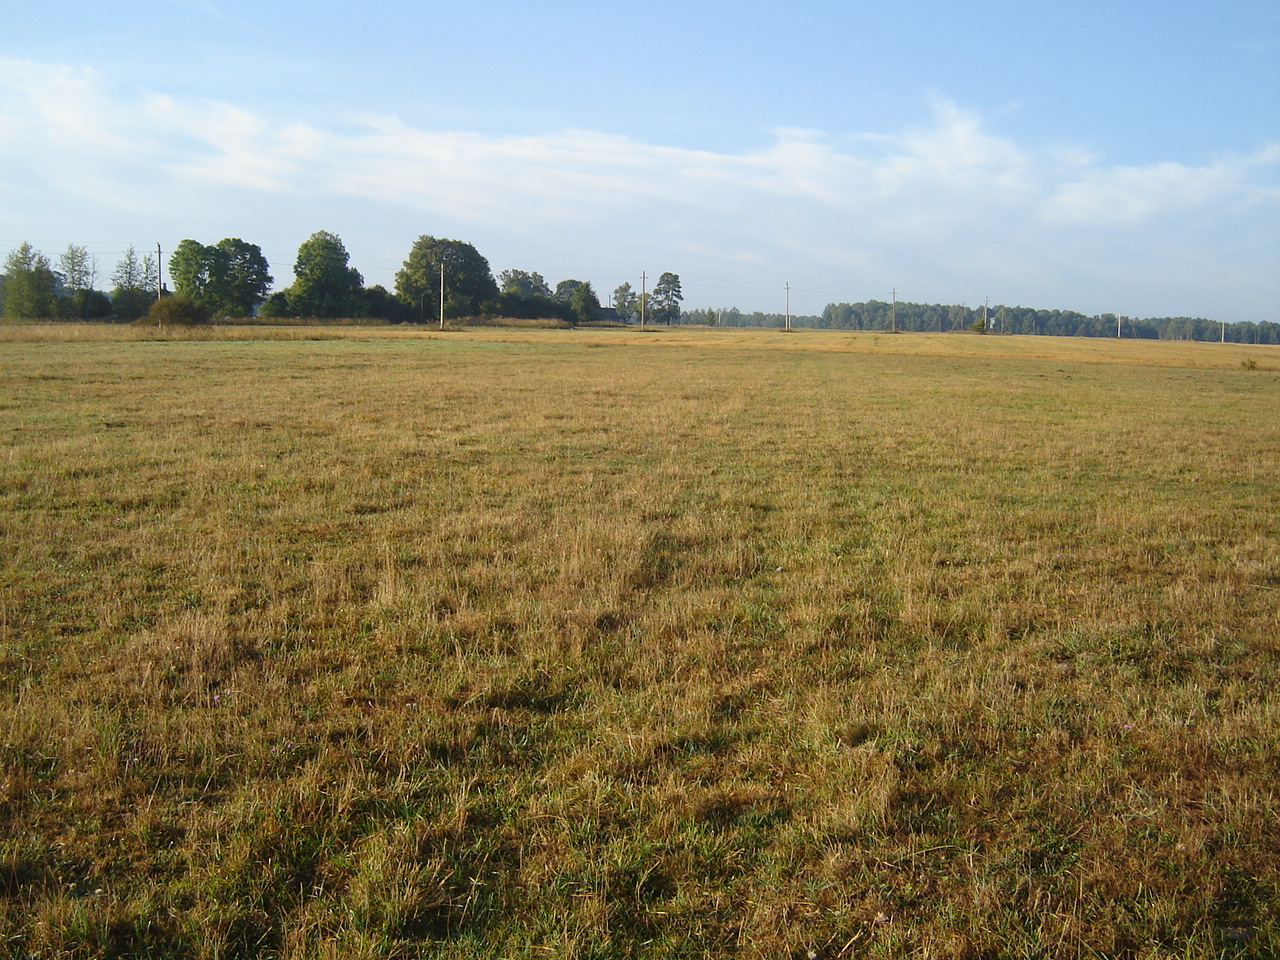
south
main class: Grassland
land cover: Grassland without tree/shrub cover
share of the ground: > 75 %
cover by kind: herbaceous plants 100 %
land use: Agriculture (excluding fallow land and kitchen gardens)
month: September
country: LT
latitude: 54.2383
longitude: 24.9827
